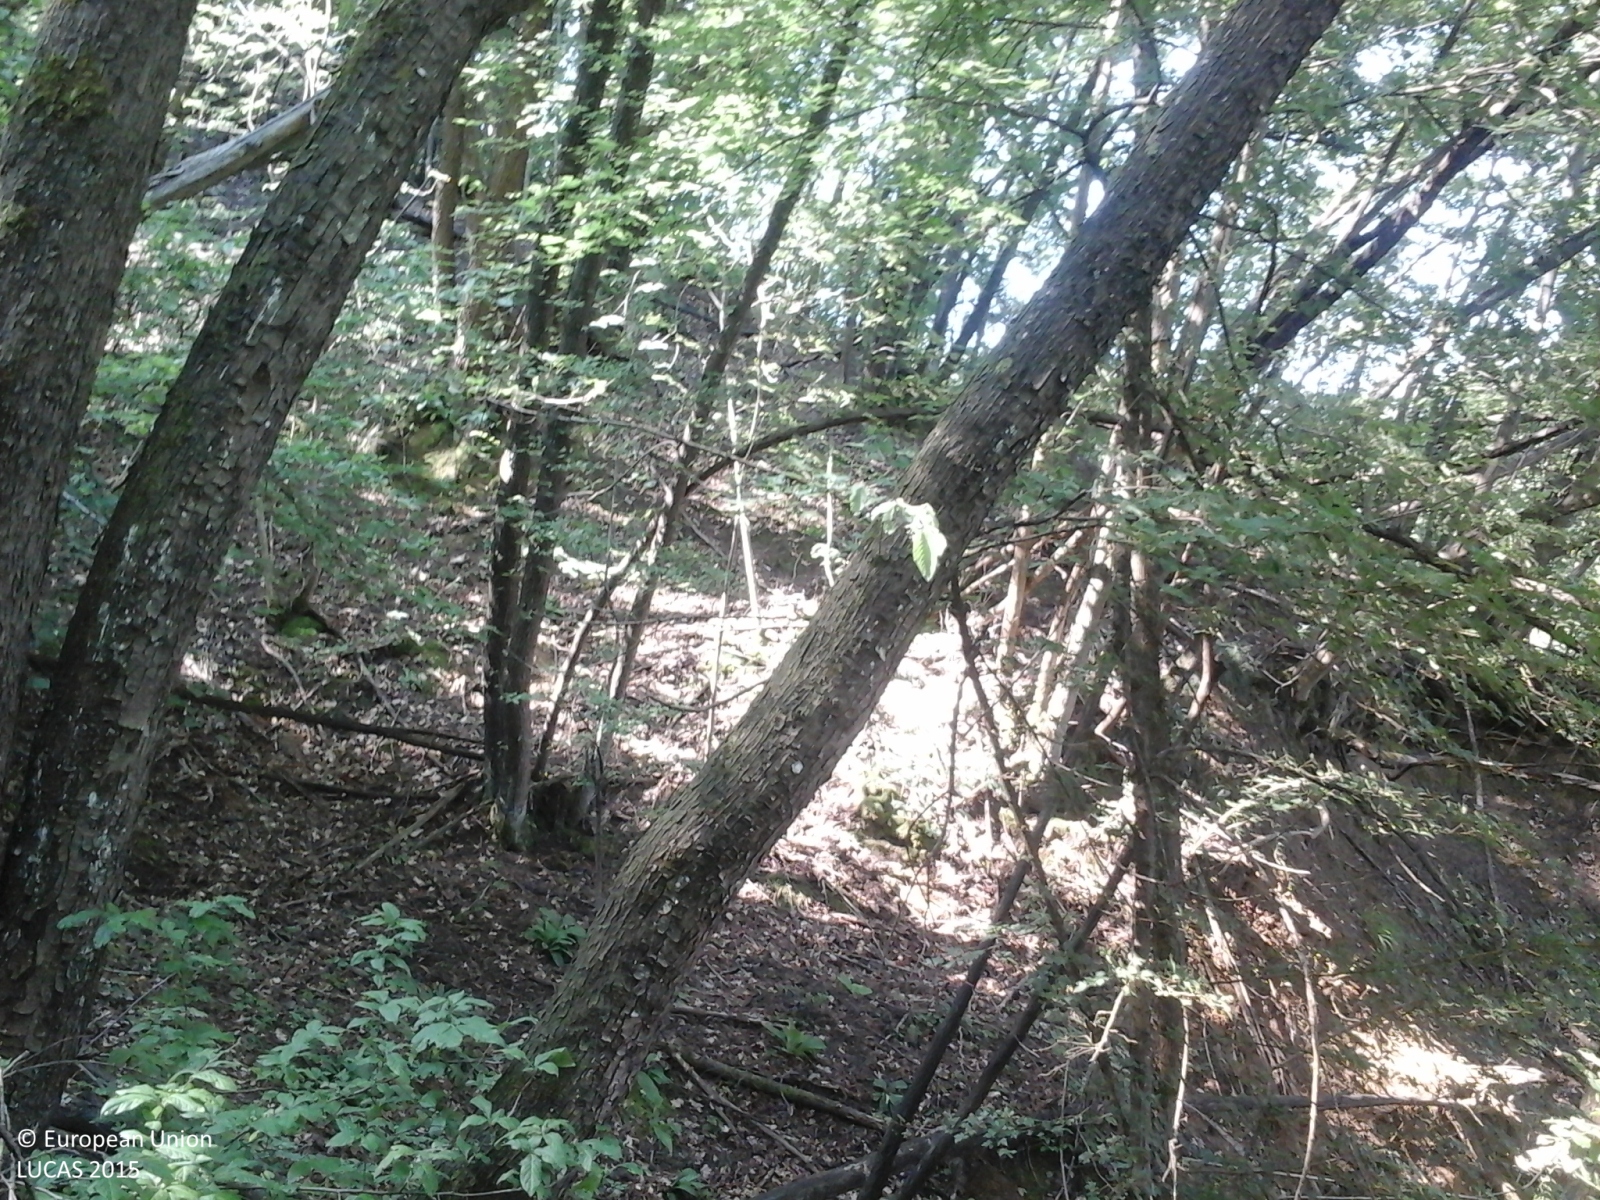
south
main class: Woodland
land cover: Broadleaved woodland
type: thermophilous deciduous forest
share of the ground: > 75 %
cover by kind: broadleaved forest trees 100 %
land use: Forestry
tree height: > 5 m
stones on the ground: < 10 %
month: June
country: IT
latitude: 44.3978
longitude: 11.1900
